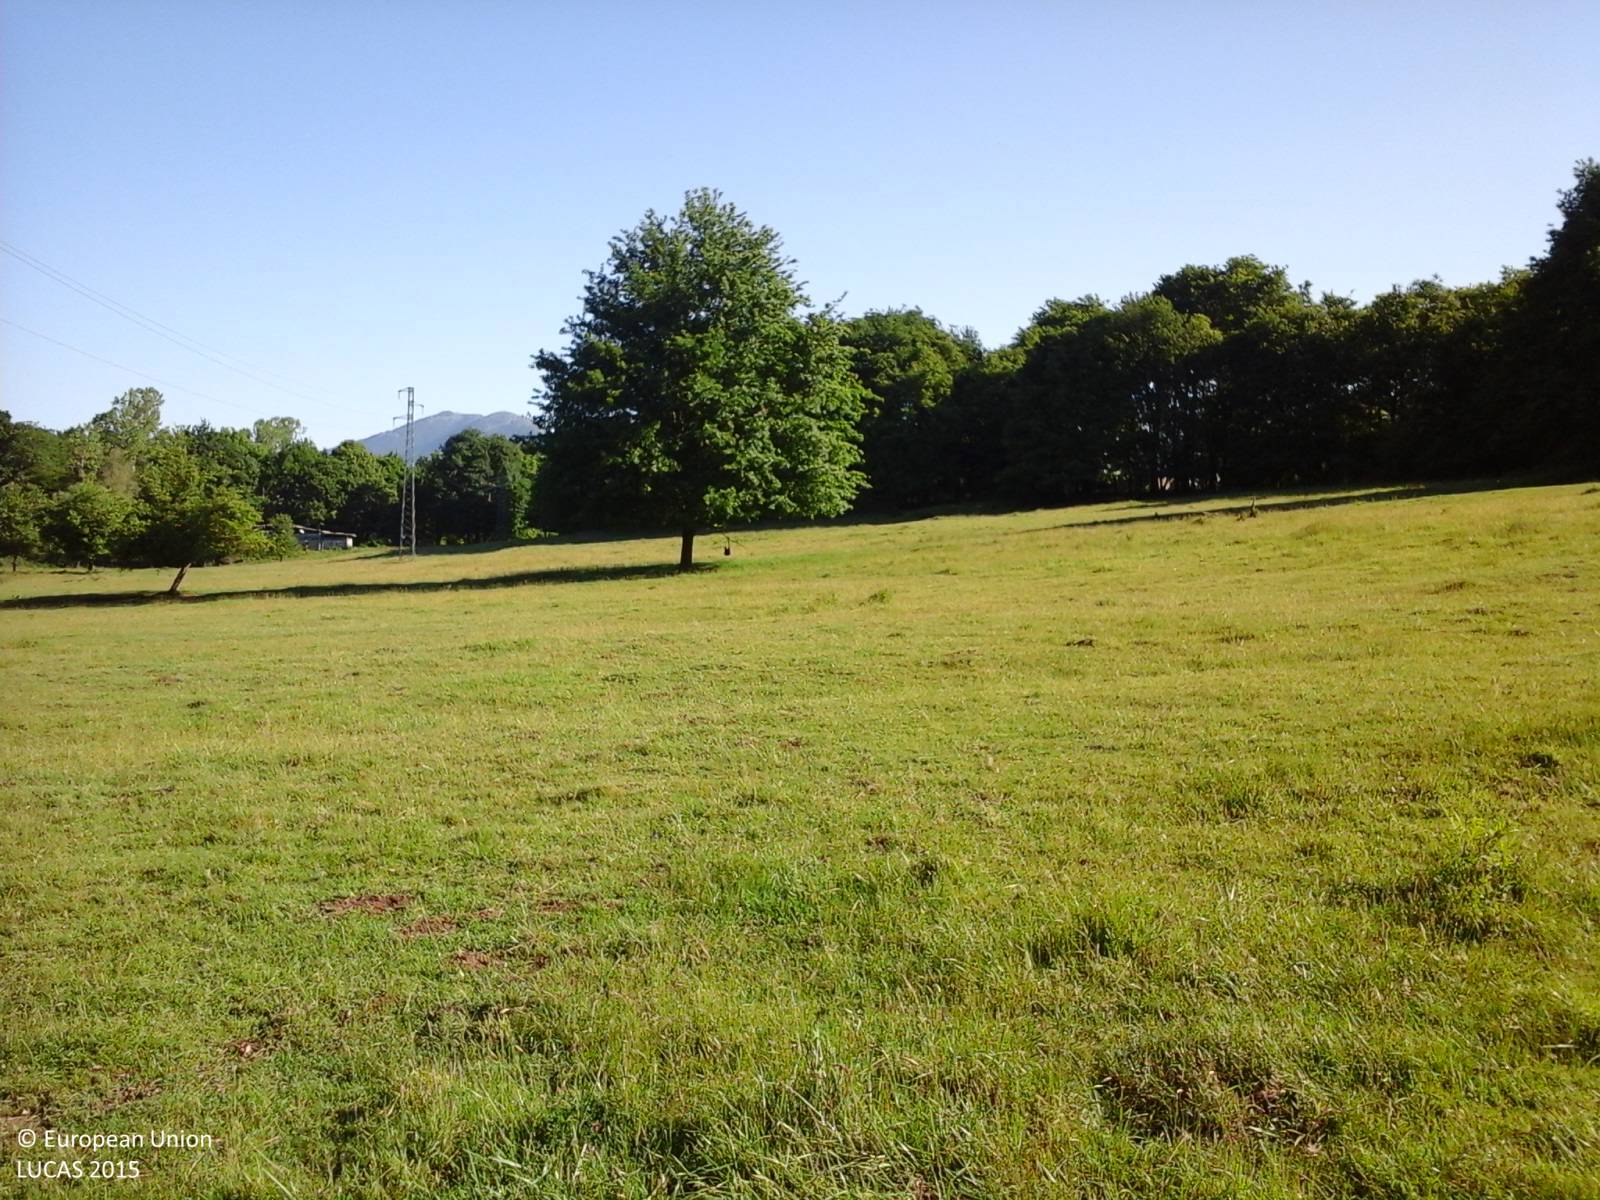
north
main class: Grassland
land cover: Grassland without tree/shrub cover
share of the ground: > 75 %
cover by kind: herbaceous plants 100 %
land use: Agriculture (excluding fallow land and kitchen gardens)
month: May
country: IT
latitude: 42.0840
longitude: 13.0478
